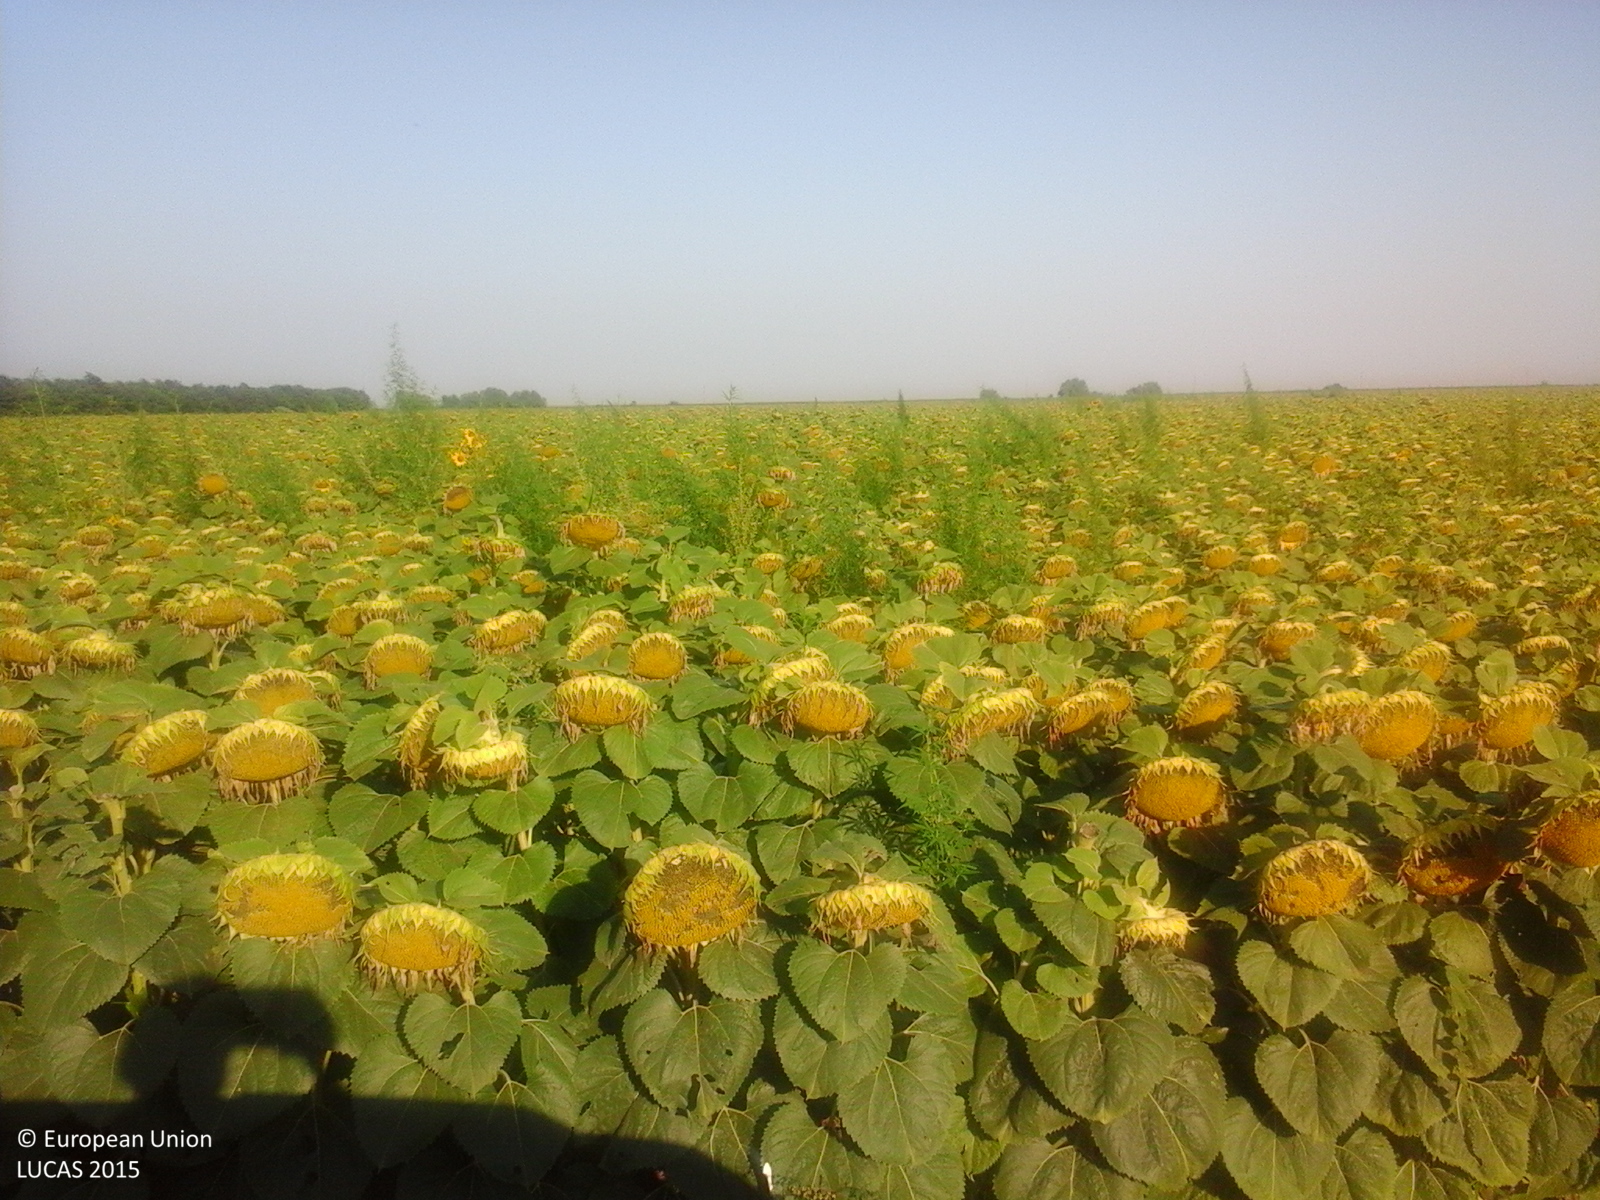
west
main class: Cropland
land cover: Sunflower
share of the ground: > 75 %
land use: Agriculture (excluding fallow land and kitchen gardens)
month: July
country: RO
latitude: 44.4982
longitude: 27.2267
